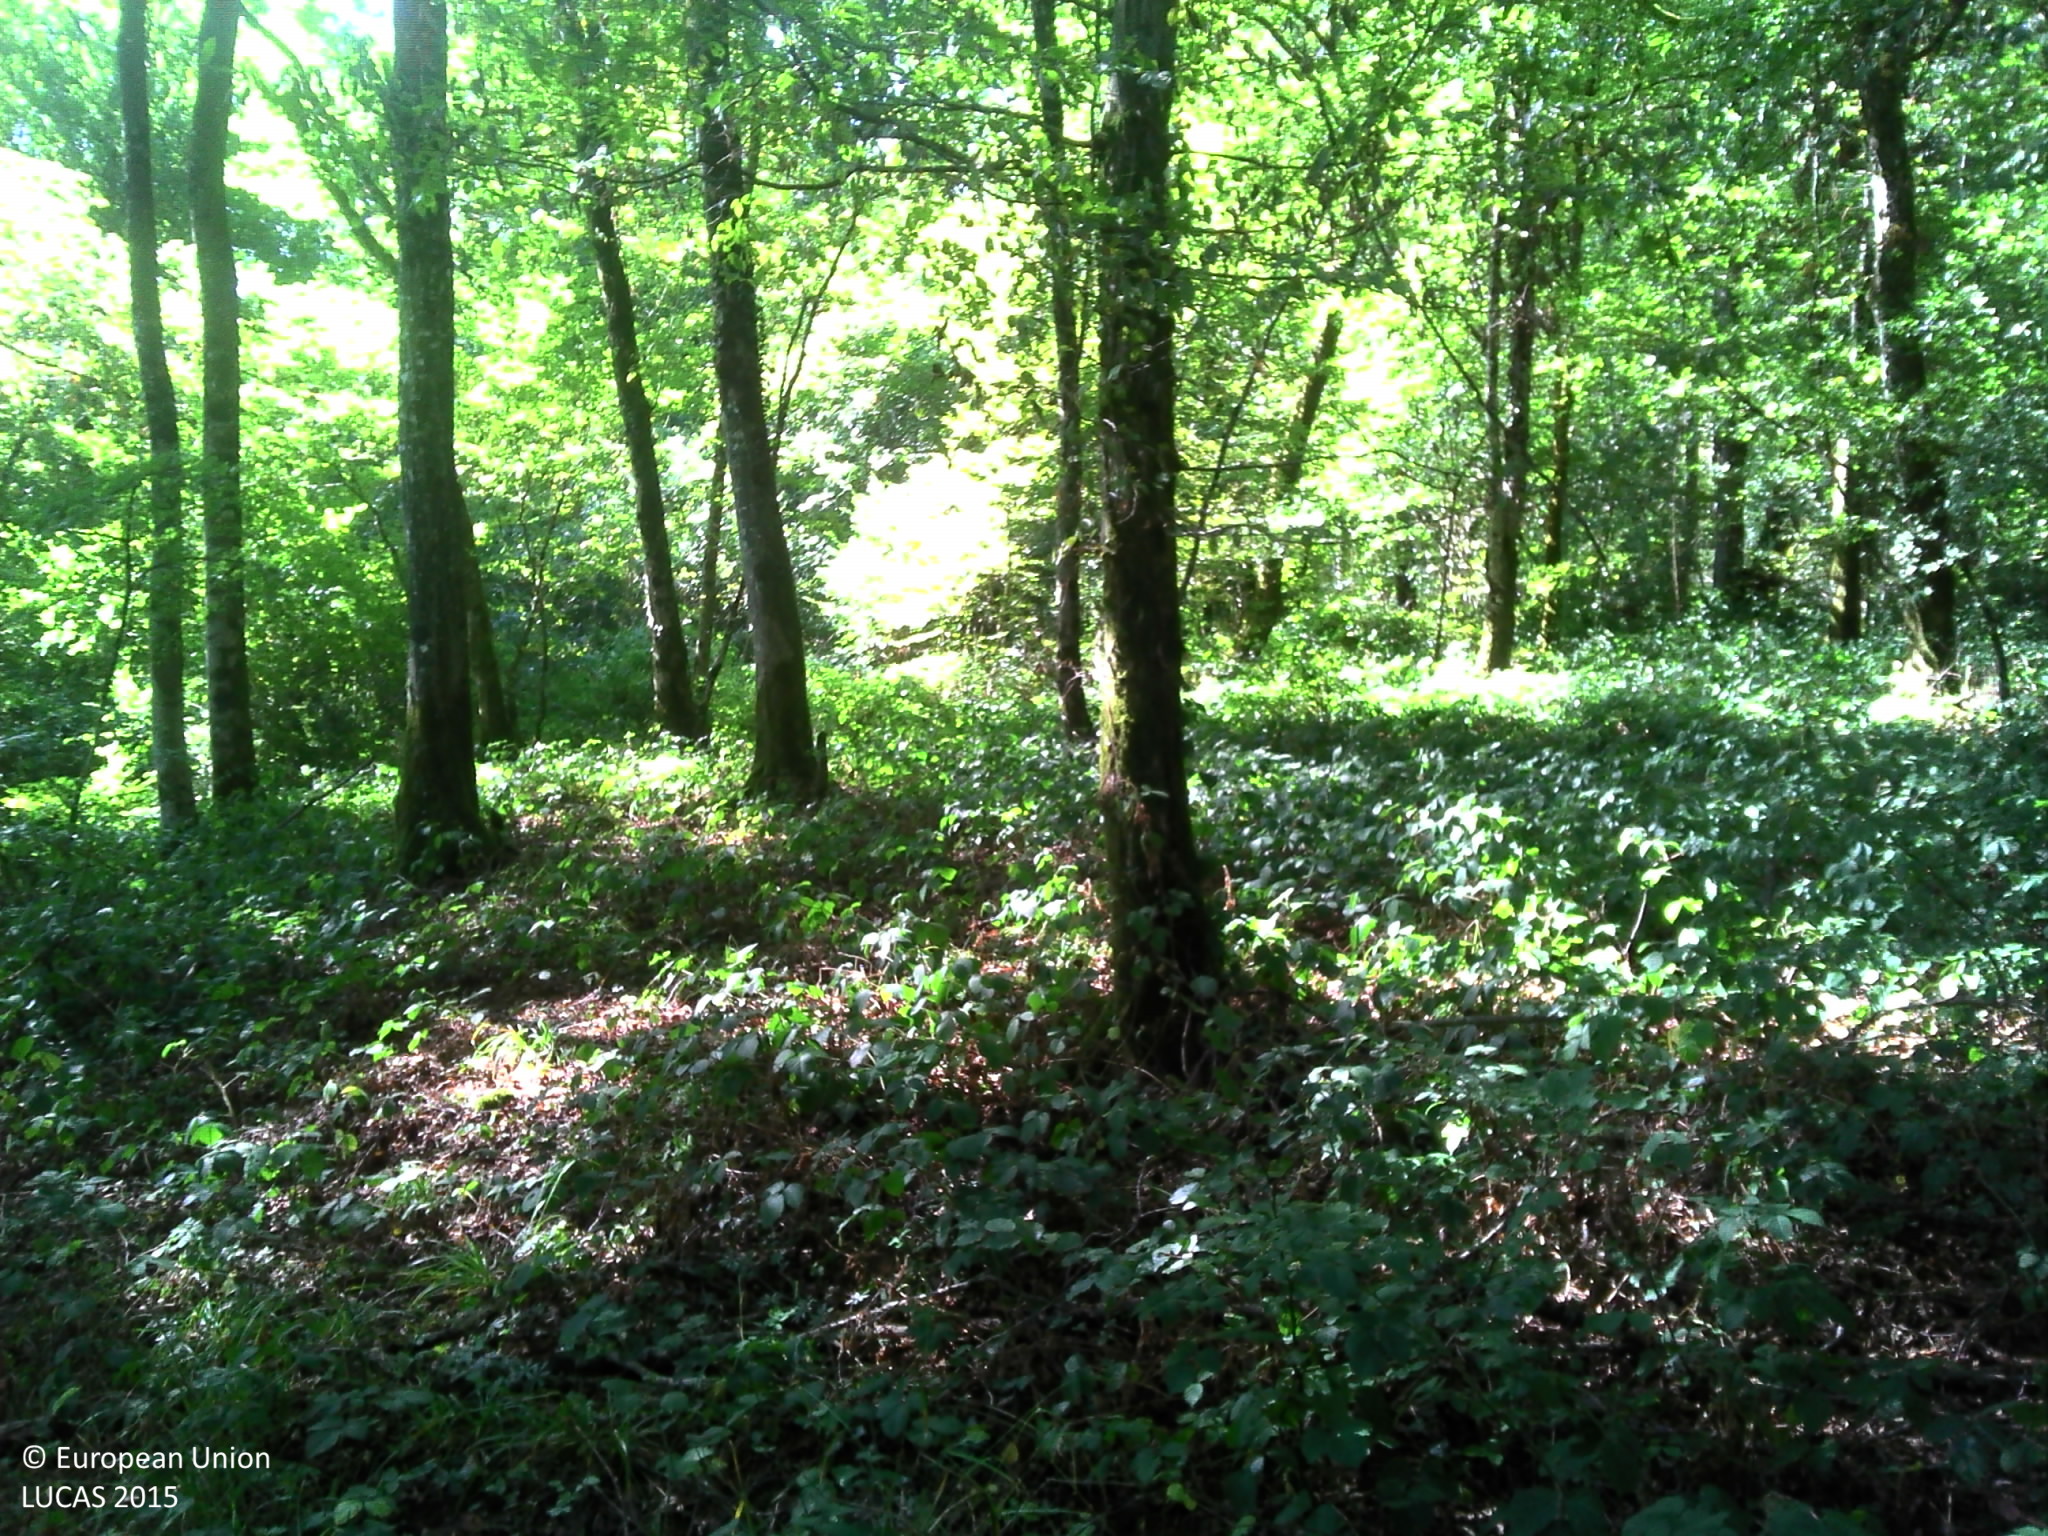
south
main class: Woodland
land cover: Broadleaved woodland
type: beech forest
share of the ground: > 75 %
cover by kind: broadleaved forest trees 100 %
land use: Forestry
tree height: > 5 m
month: September
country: FR
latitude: 47.3879
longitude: 6.3322
